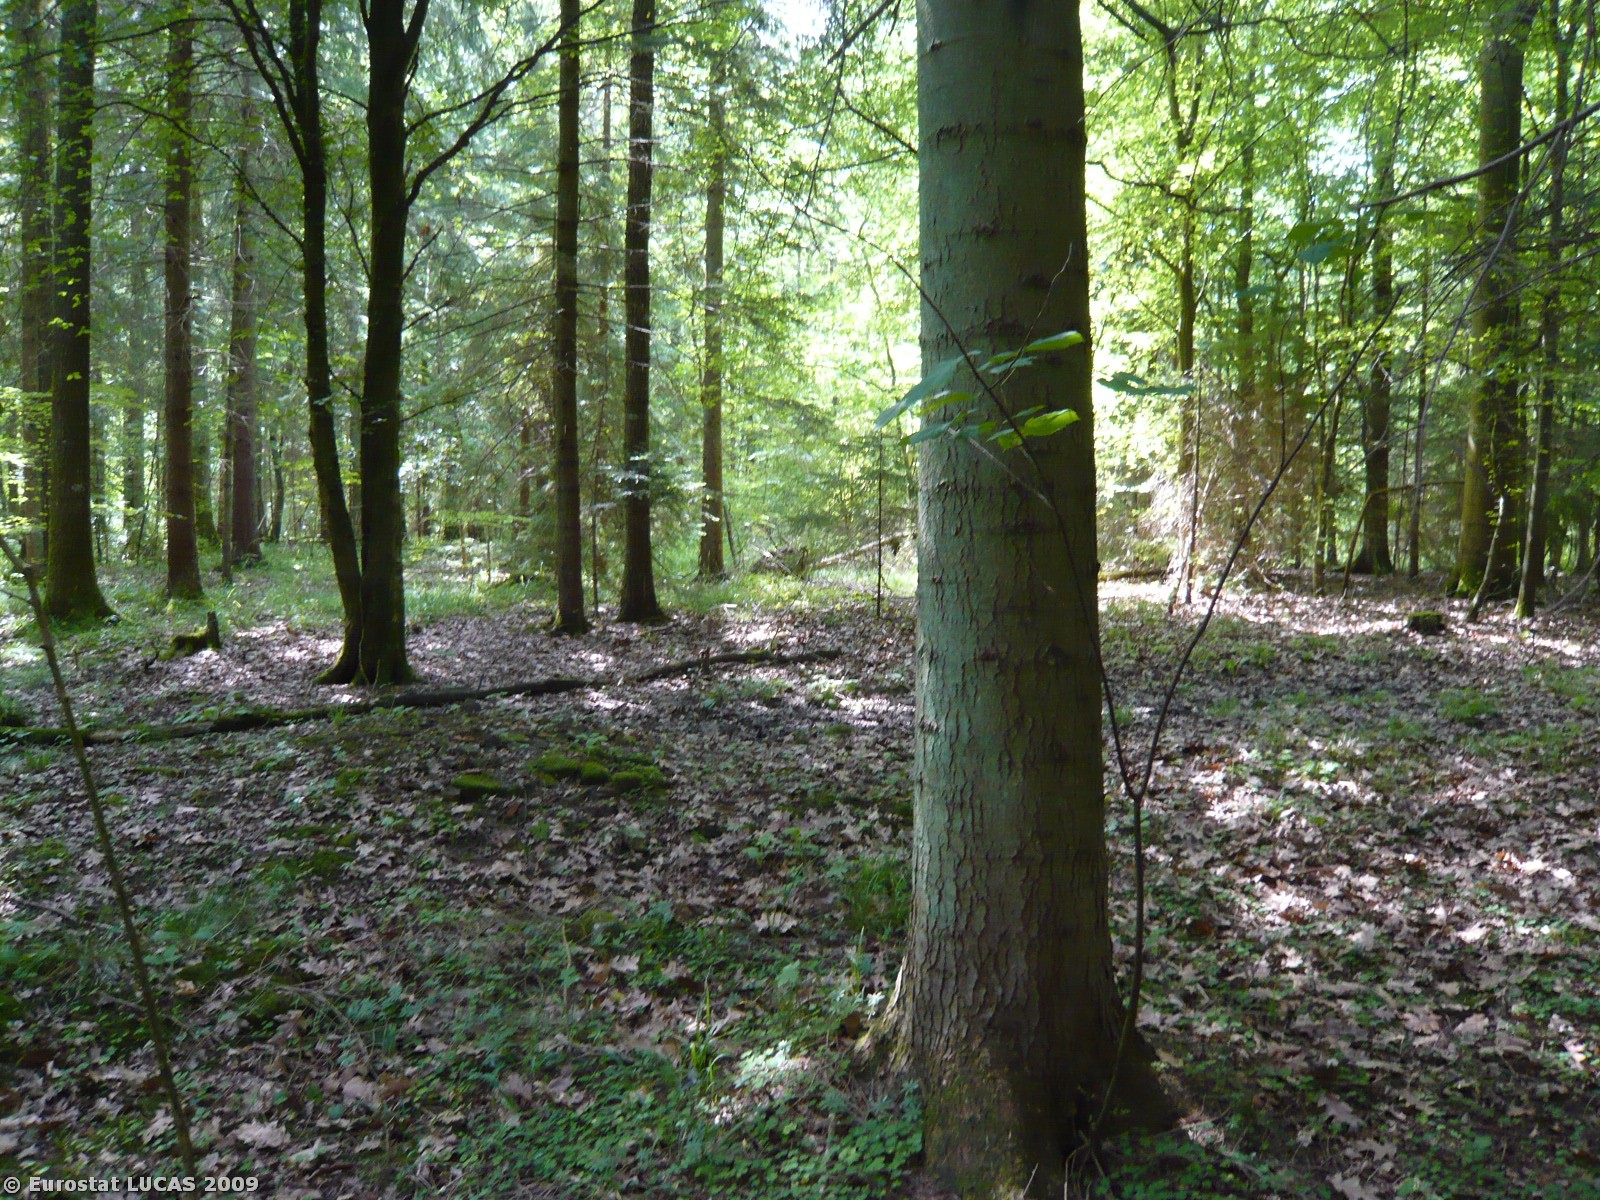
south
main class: Woodland
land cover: Coniferous woodland
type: hemiboreal forest and nemoral coniferous forest and mixed broadleaved-coniferous forest
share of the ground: > 75 %
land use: Forestry
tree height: > 5 m
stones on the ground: < 10 %
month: July
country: DK
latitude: 55.5451
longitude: 11.8527
